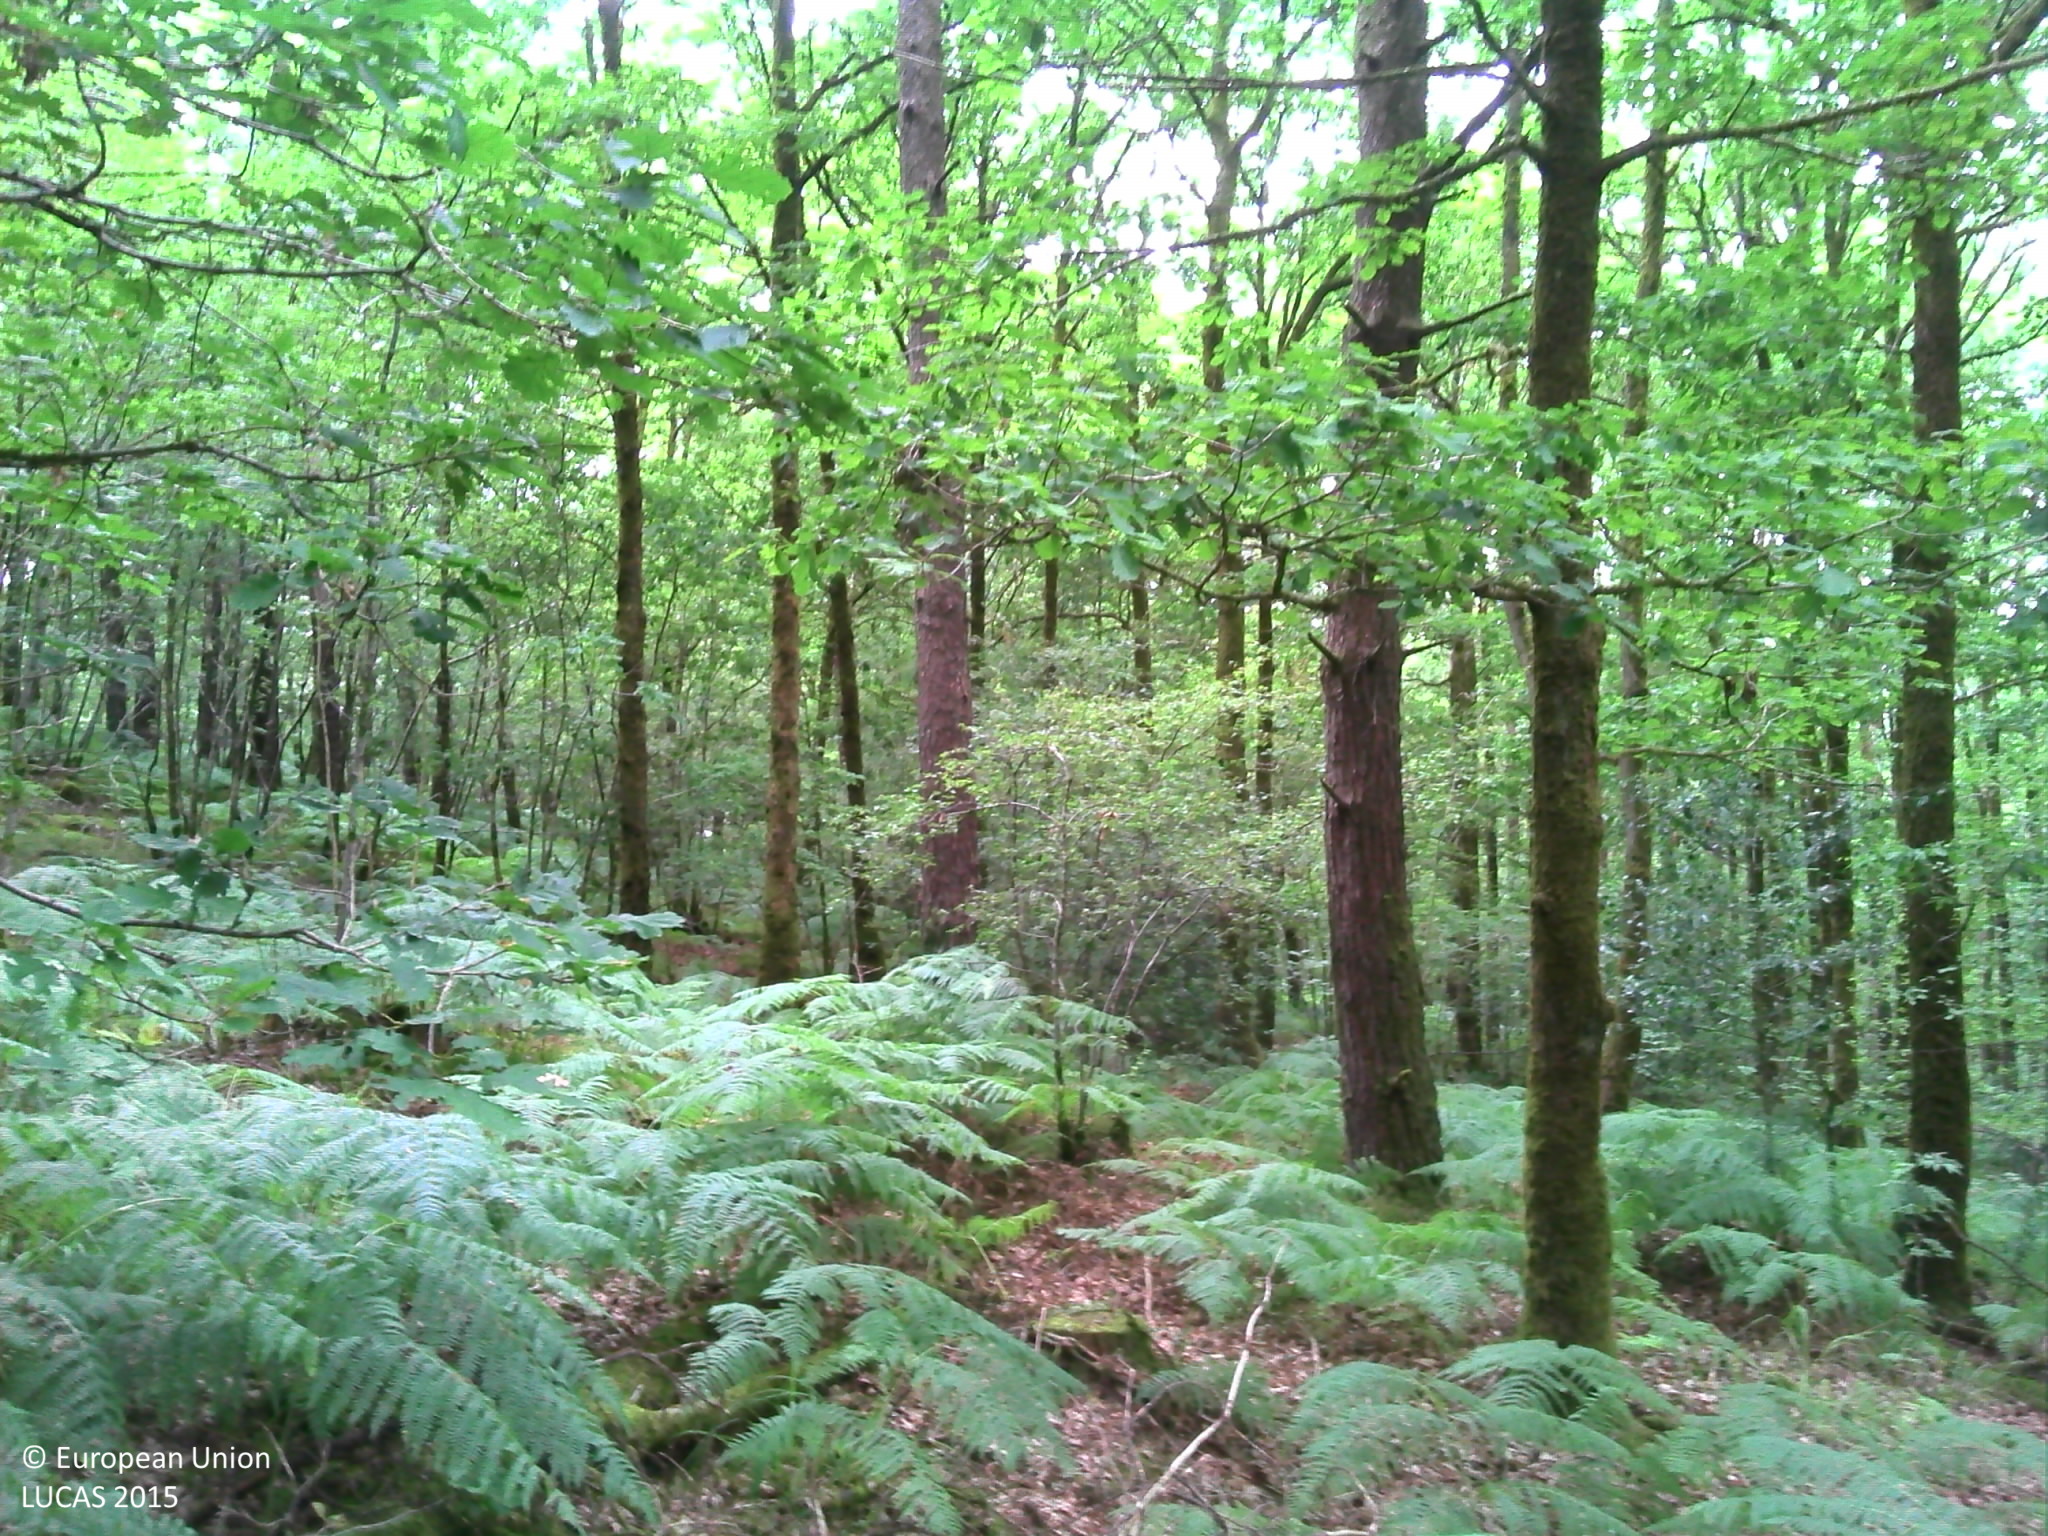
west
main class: Woodland
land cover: Pine dominated mixed woodland
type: acidophilous oak and oak-birch forest
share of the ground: > 75 %
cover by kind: broadleaved forest trees 50 %, coniferous forest trees 30 %, herbaceous plants 20 %
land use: Forestry
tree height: > 5 m
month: July
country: FR
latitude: 48.4473
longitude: -0.1026
